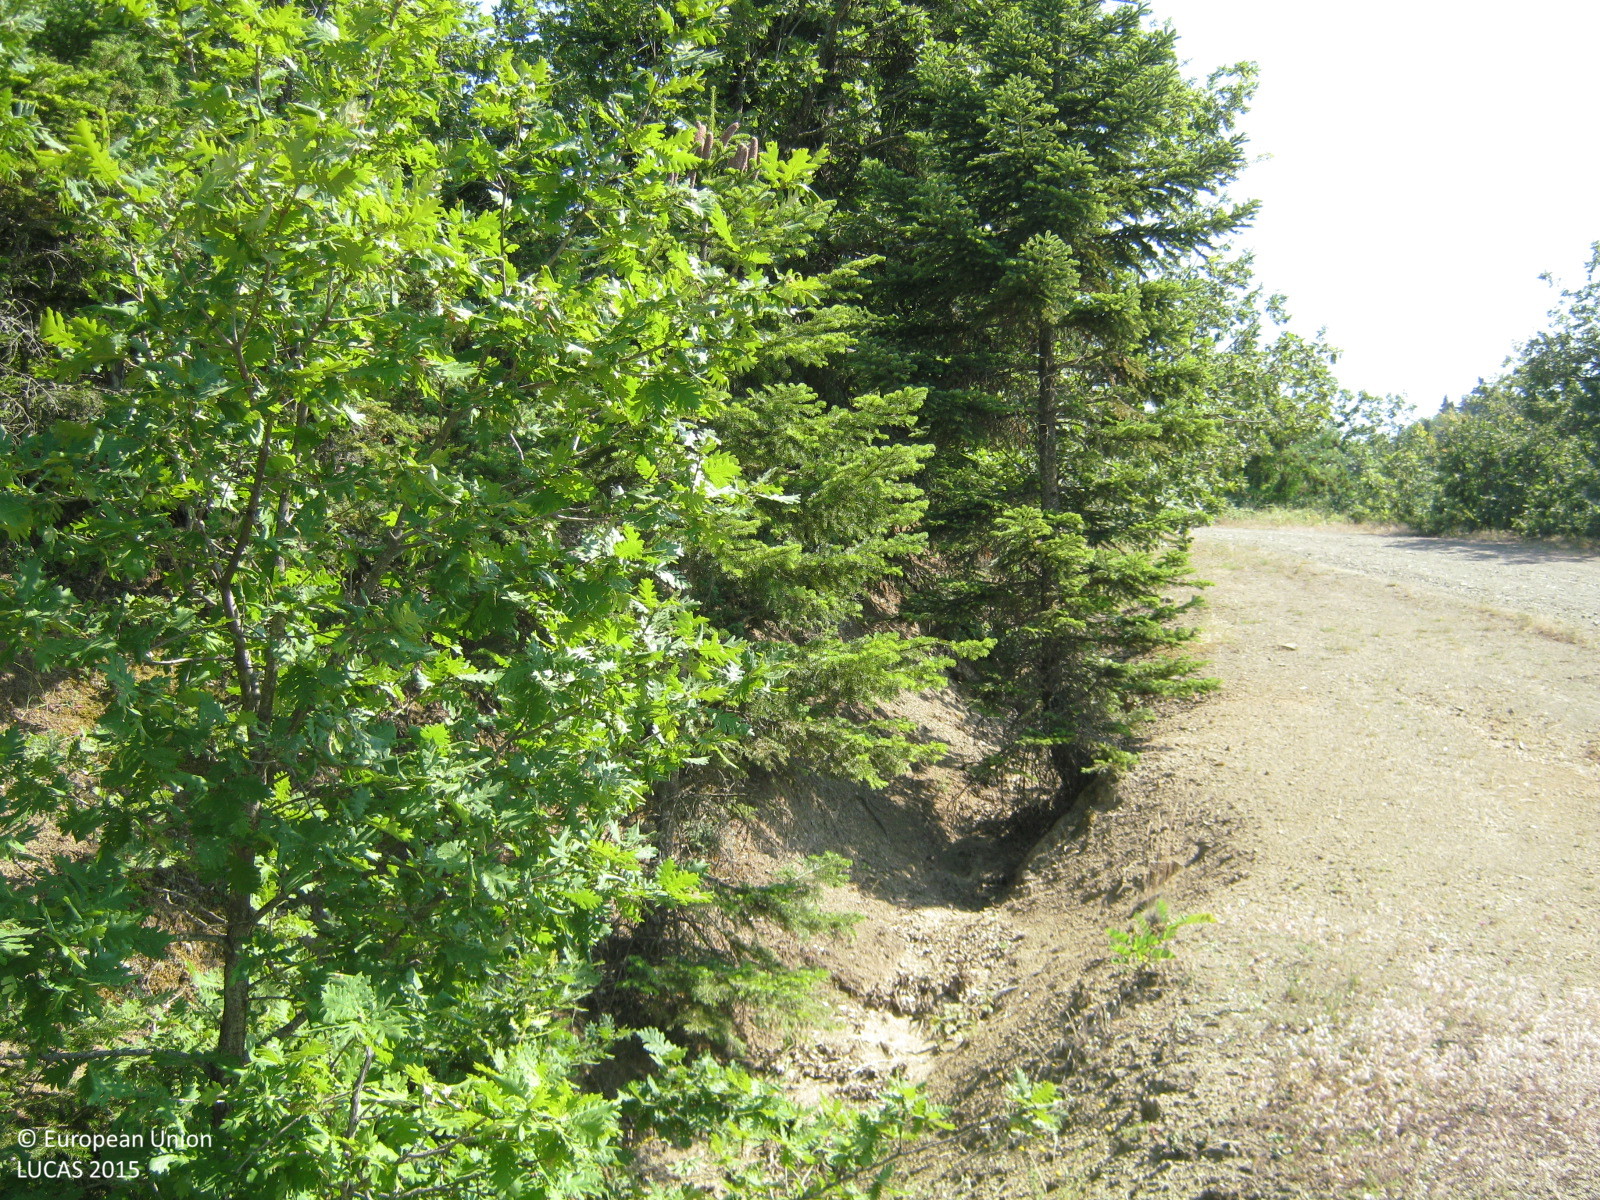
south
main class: Woodland
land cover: Spruce dominated mixed woodland
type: coniferous forest of the mediterranean region
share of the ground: > 75 %
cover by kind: coniferous forest trees 50 %, broadleaved forest trees 30 %, herbaceous plants 10 %, unconsolidated bare surface 10 %
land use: Forestry
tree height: > 5 m
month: July
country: GR
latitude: 39.2257
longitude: 21.7832
